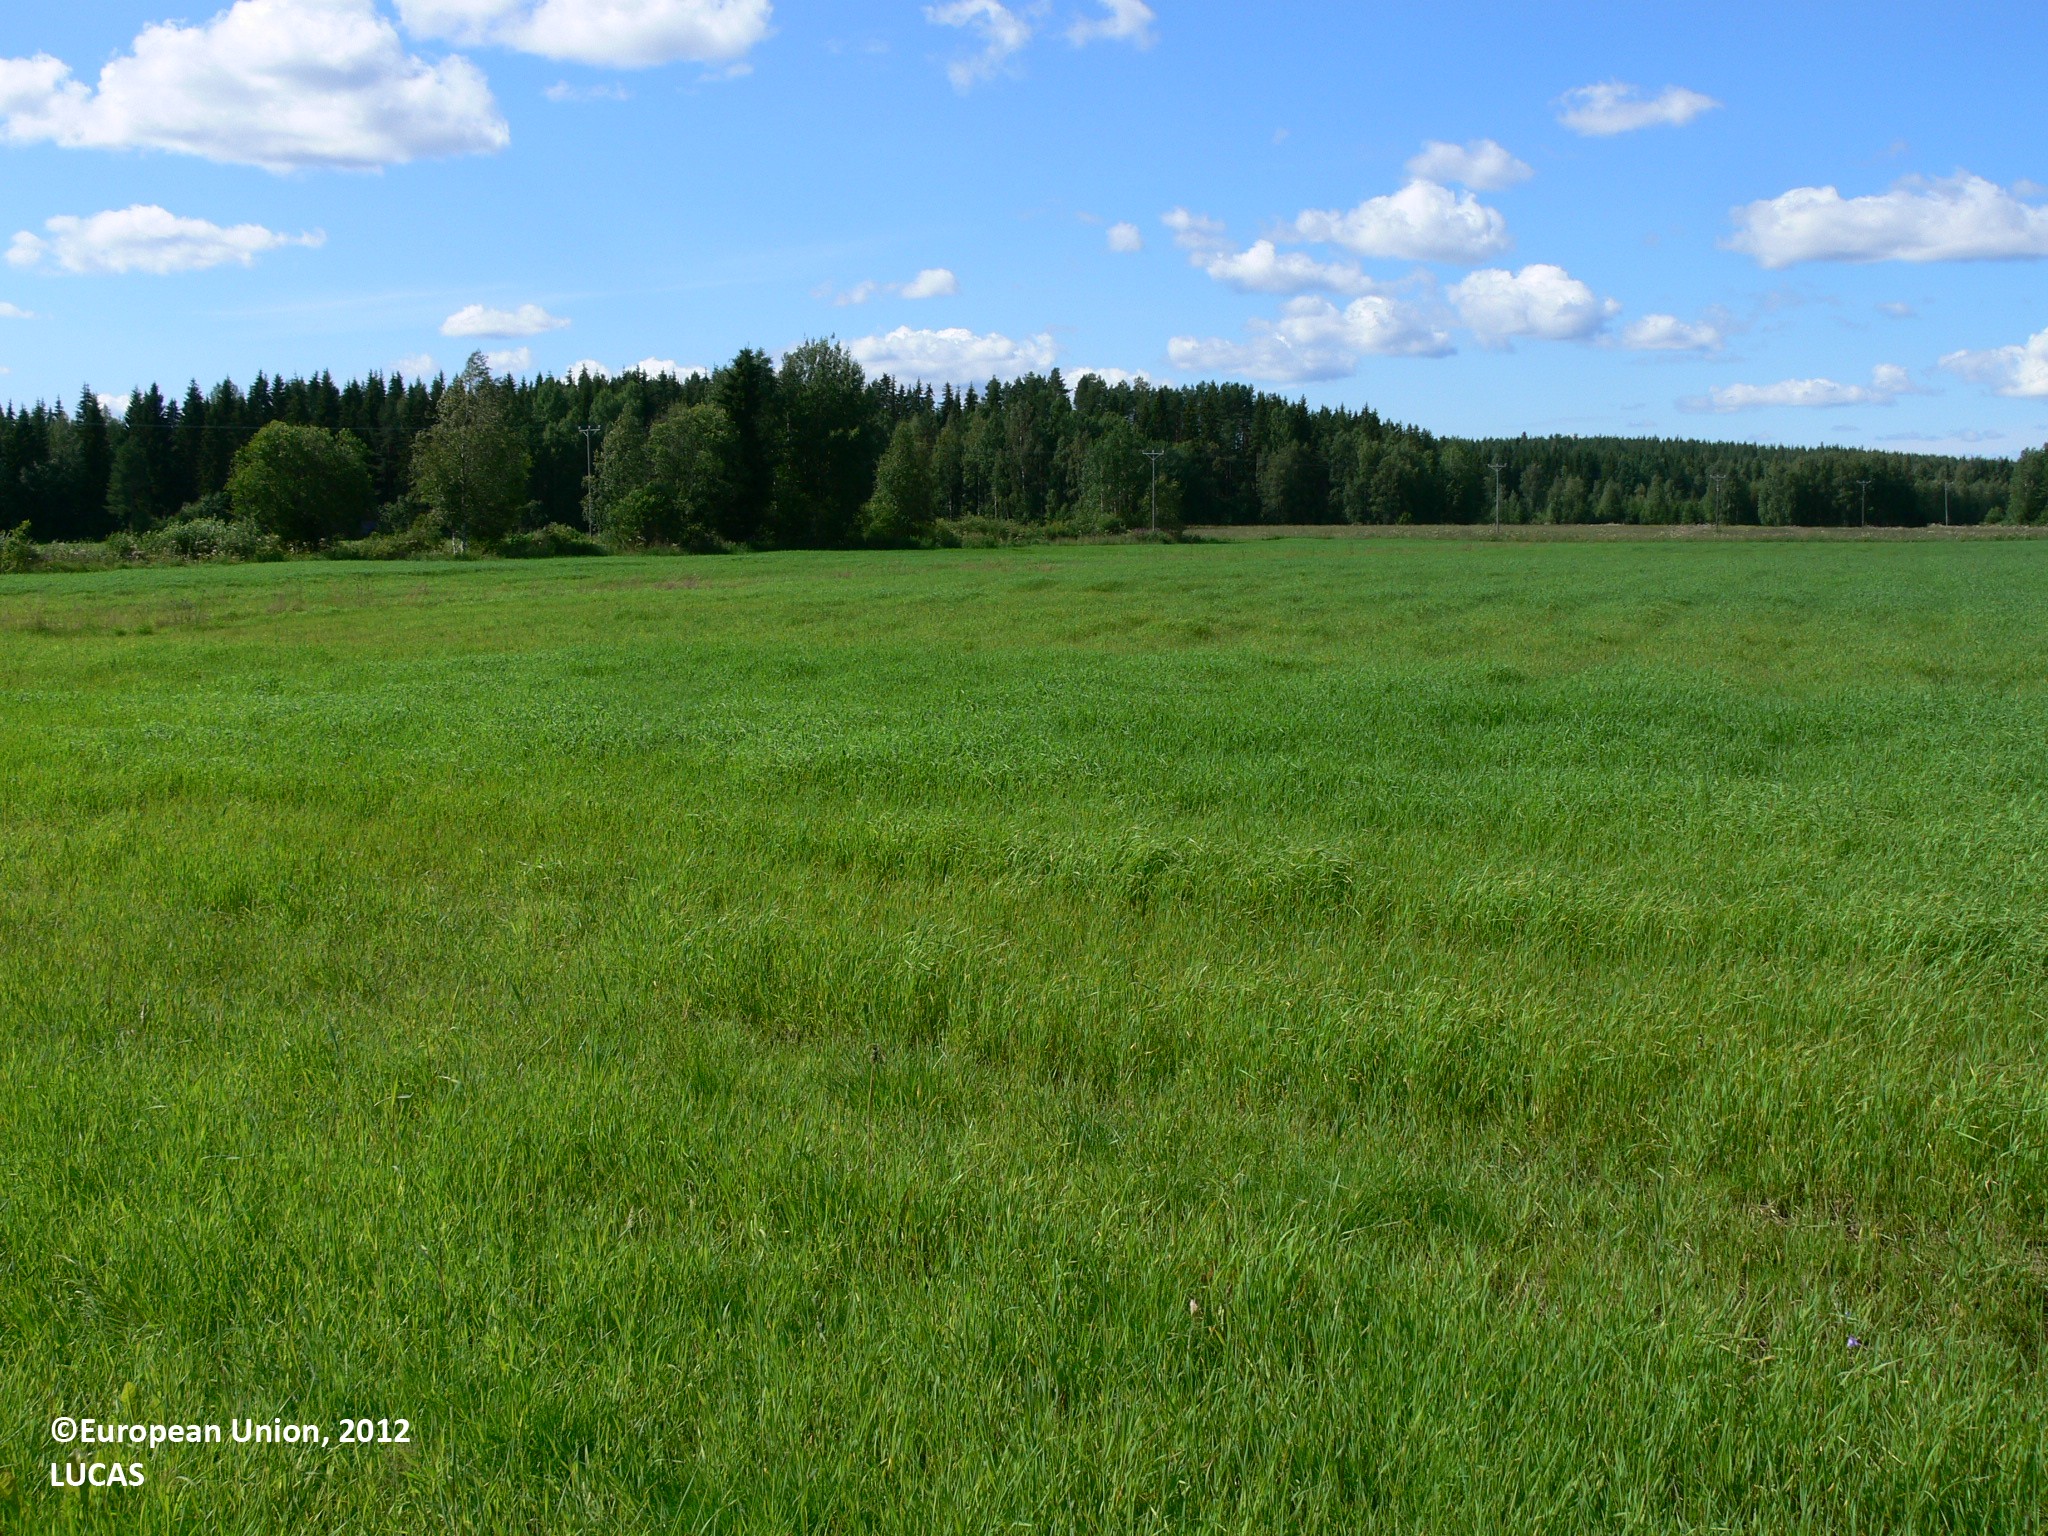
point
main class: Cropland
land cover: Temporary grasslands
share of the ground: > 75 %
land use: Agriculture (excluding fallow land and kitchen gardens)
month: July
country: FI
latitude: 63.2570
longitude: 29.2426
